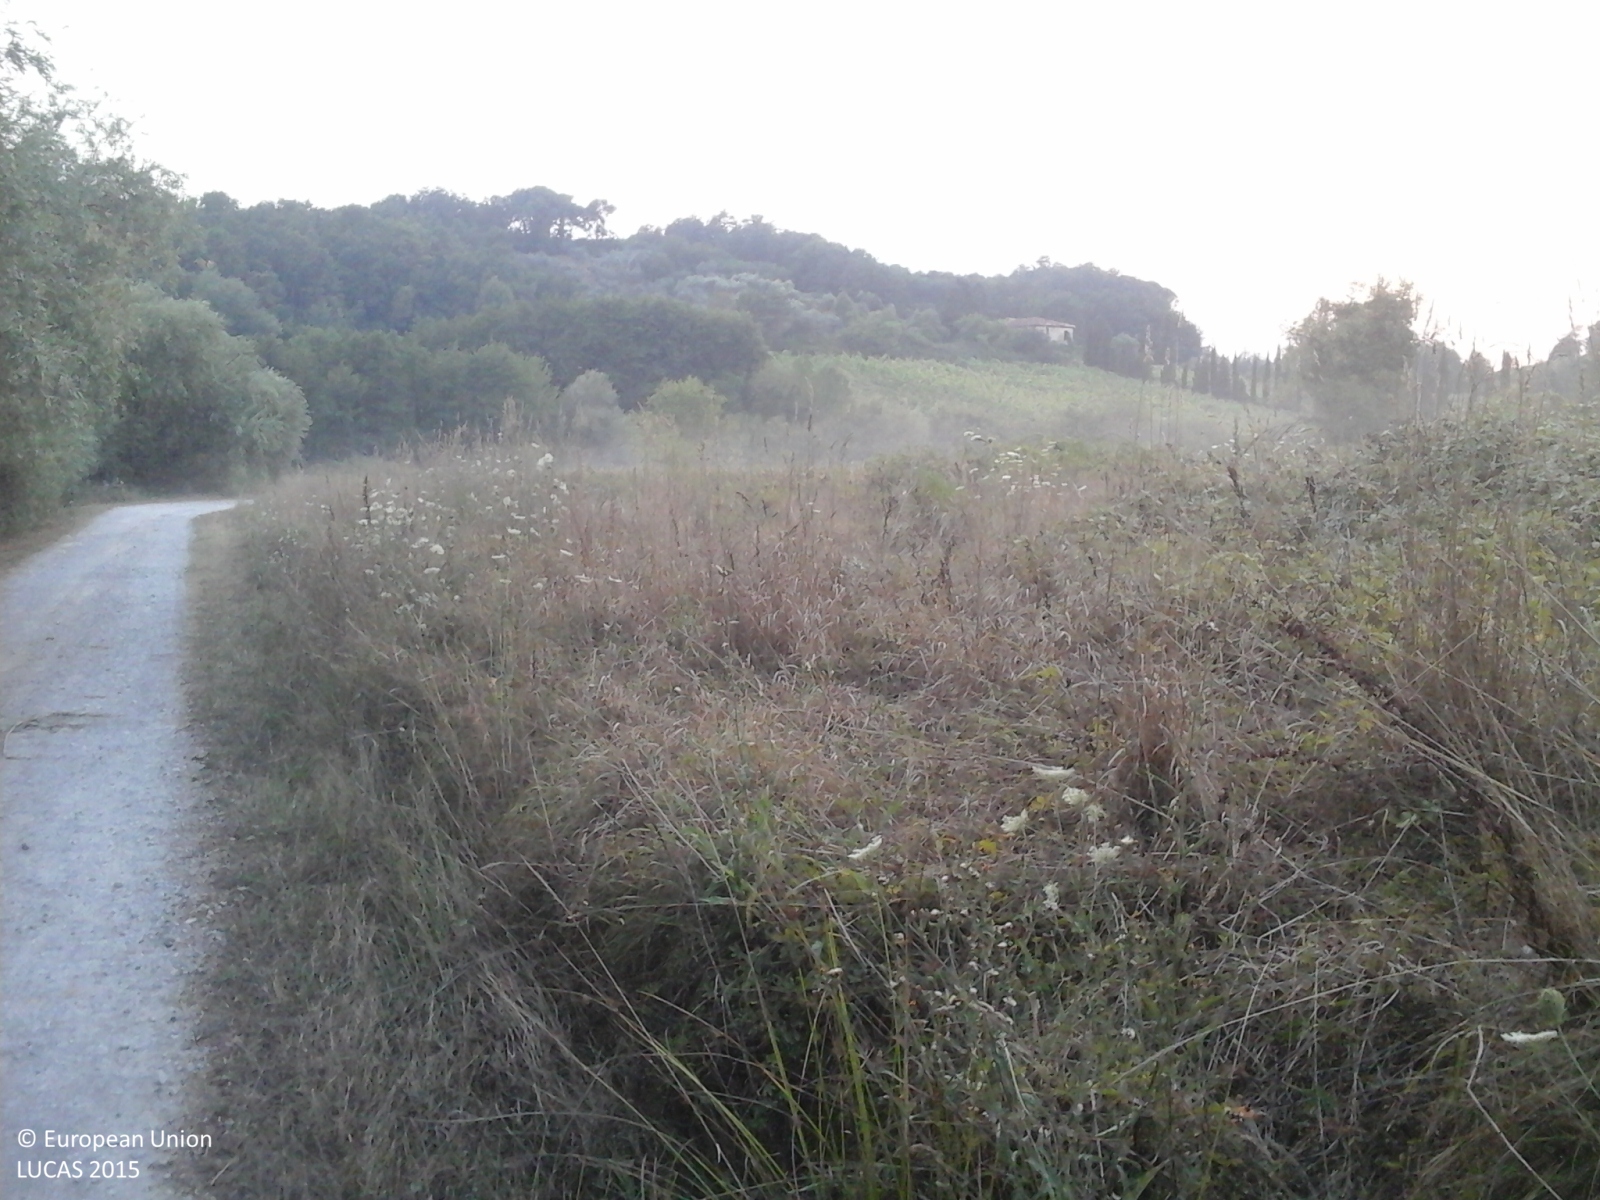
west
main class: Woodland
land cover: Broadleaved woodland
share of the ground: > 75 %
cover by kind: broadleaved forest trees 100 %
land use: Forestry
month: August
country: IT
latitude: 43.8794
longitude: 10.6579
